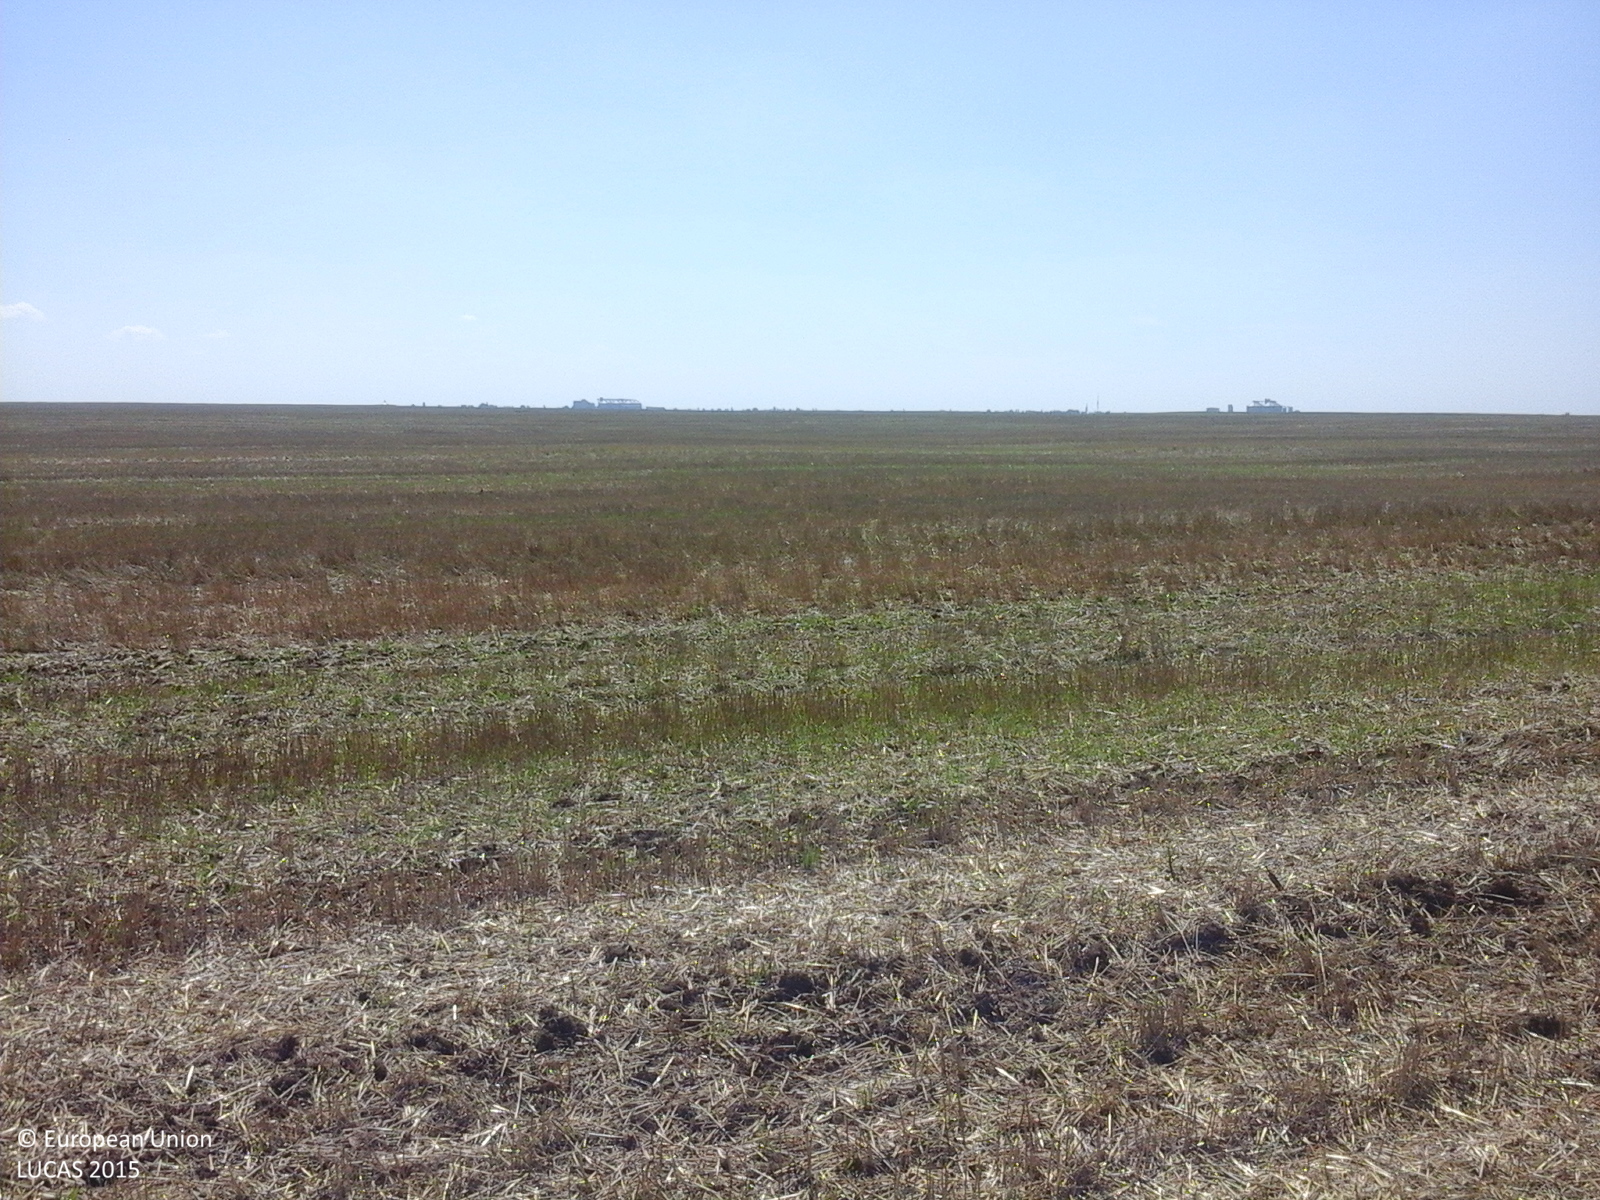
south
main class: Cropland
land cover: Common wheat
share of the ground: 50 - 75 %
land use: Agriculture (excluding fallow land and kitchen gardens)
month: August
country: RO
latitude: 45.9466
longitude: 21.1636
